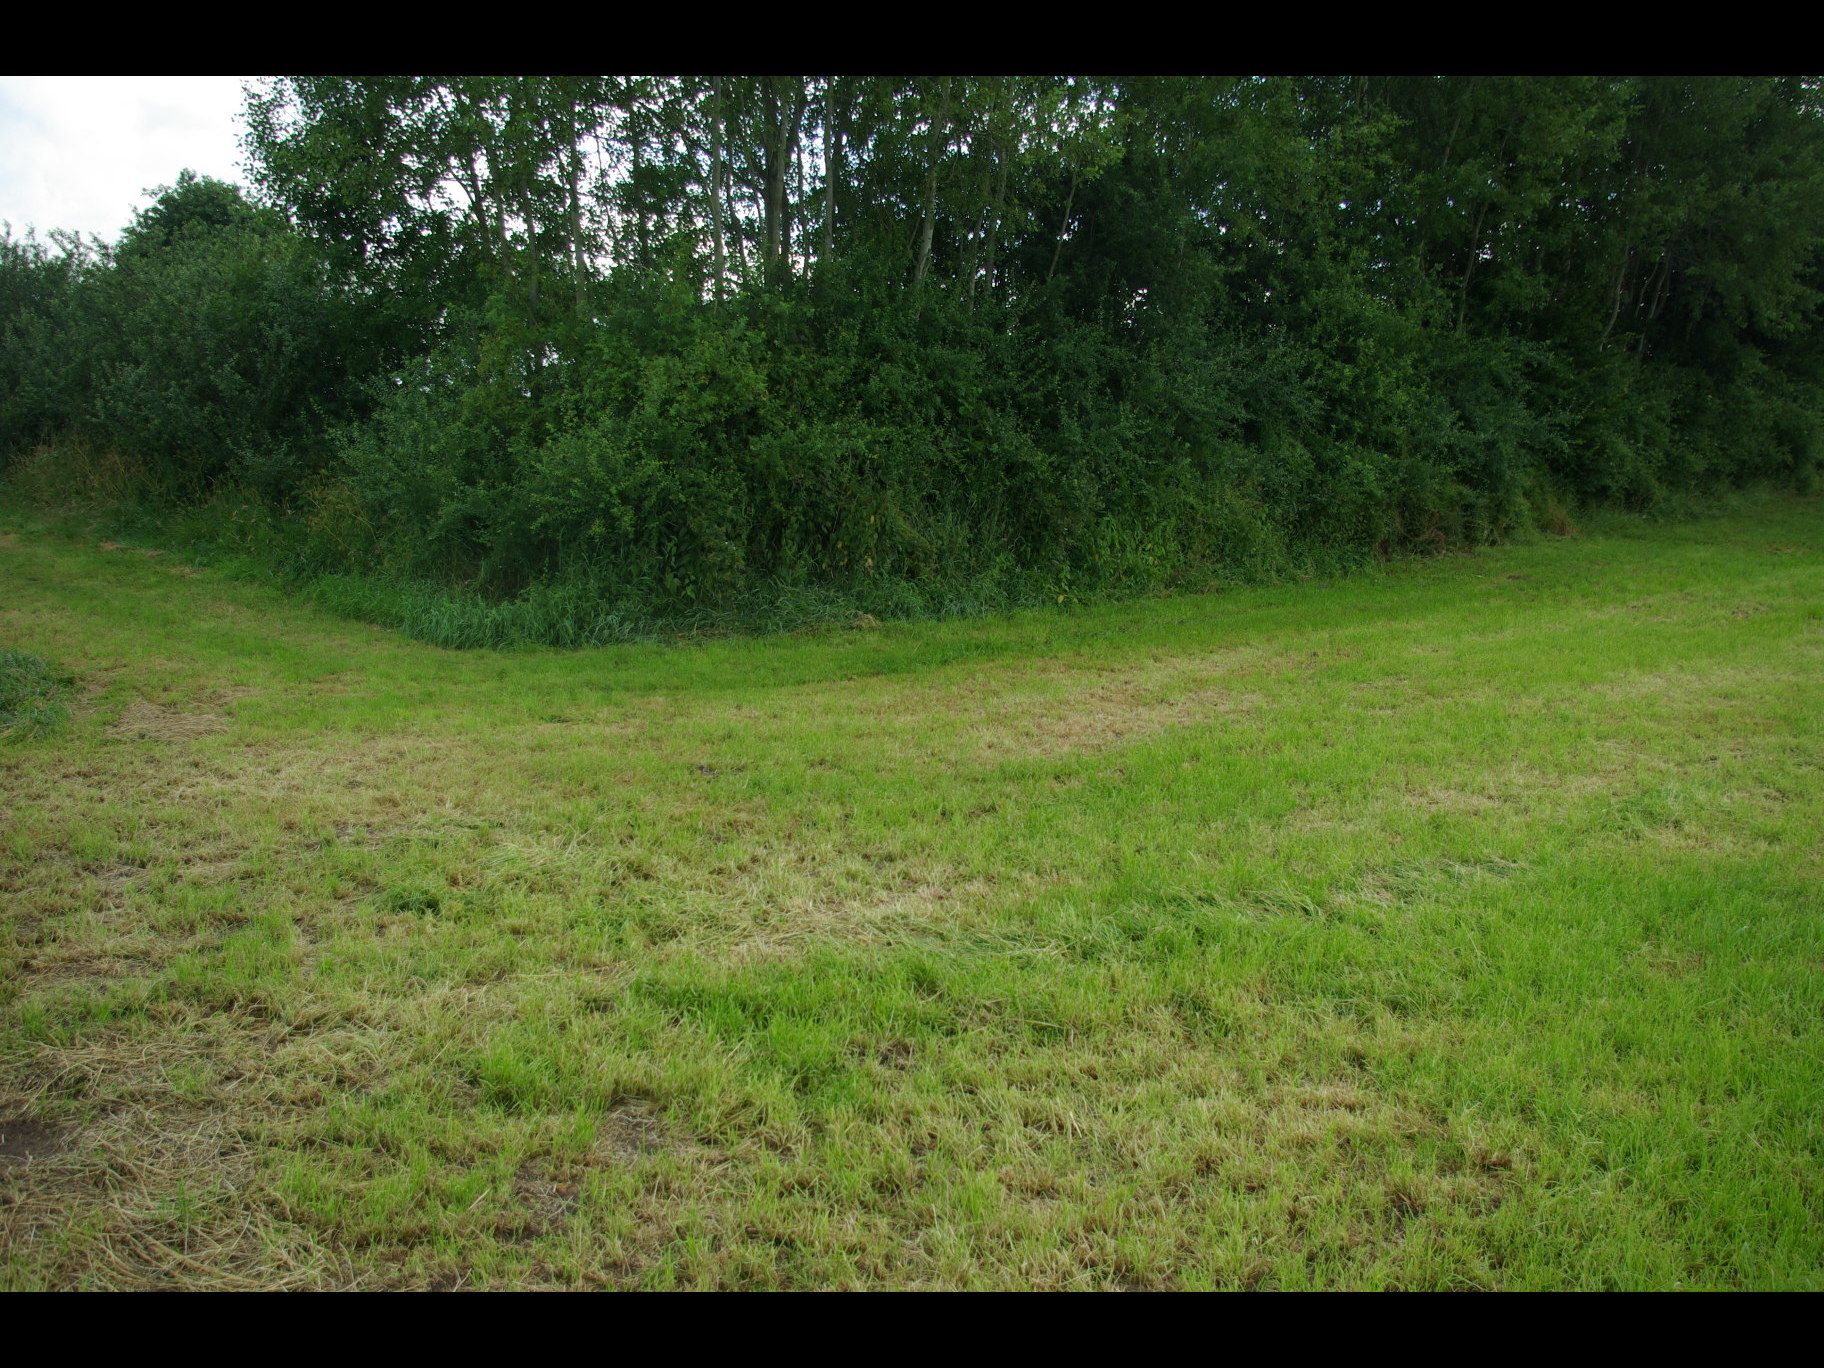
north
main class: Grassland
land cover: Grassland without tree/shrub cover
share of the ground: > 75 %
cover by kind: herbaceous plants 100 %
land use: Agriculture (excluding fallow land and kitchen gardens)
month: July
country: DE
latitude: 54.1380
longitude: 9.5564
